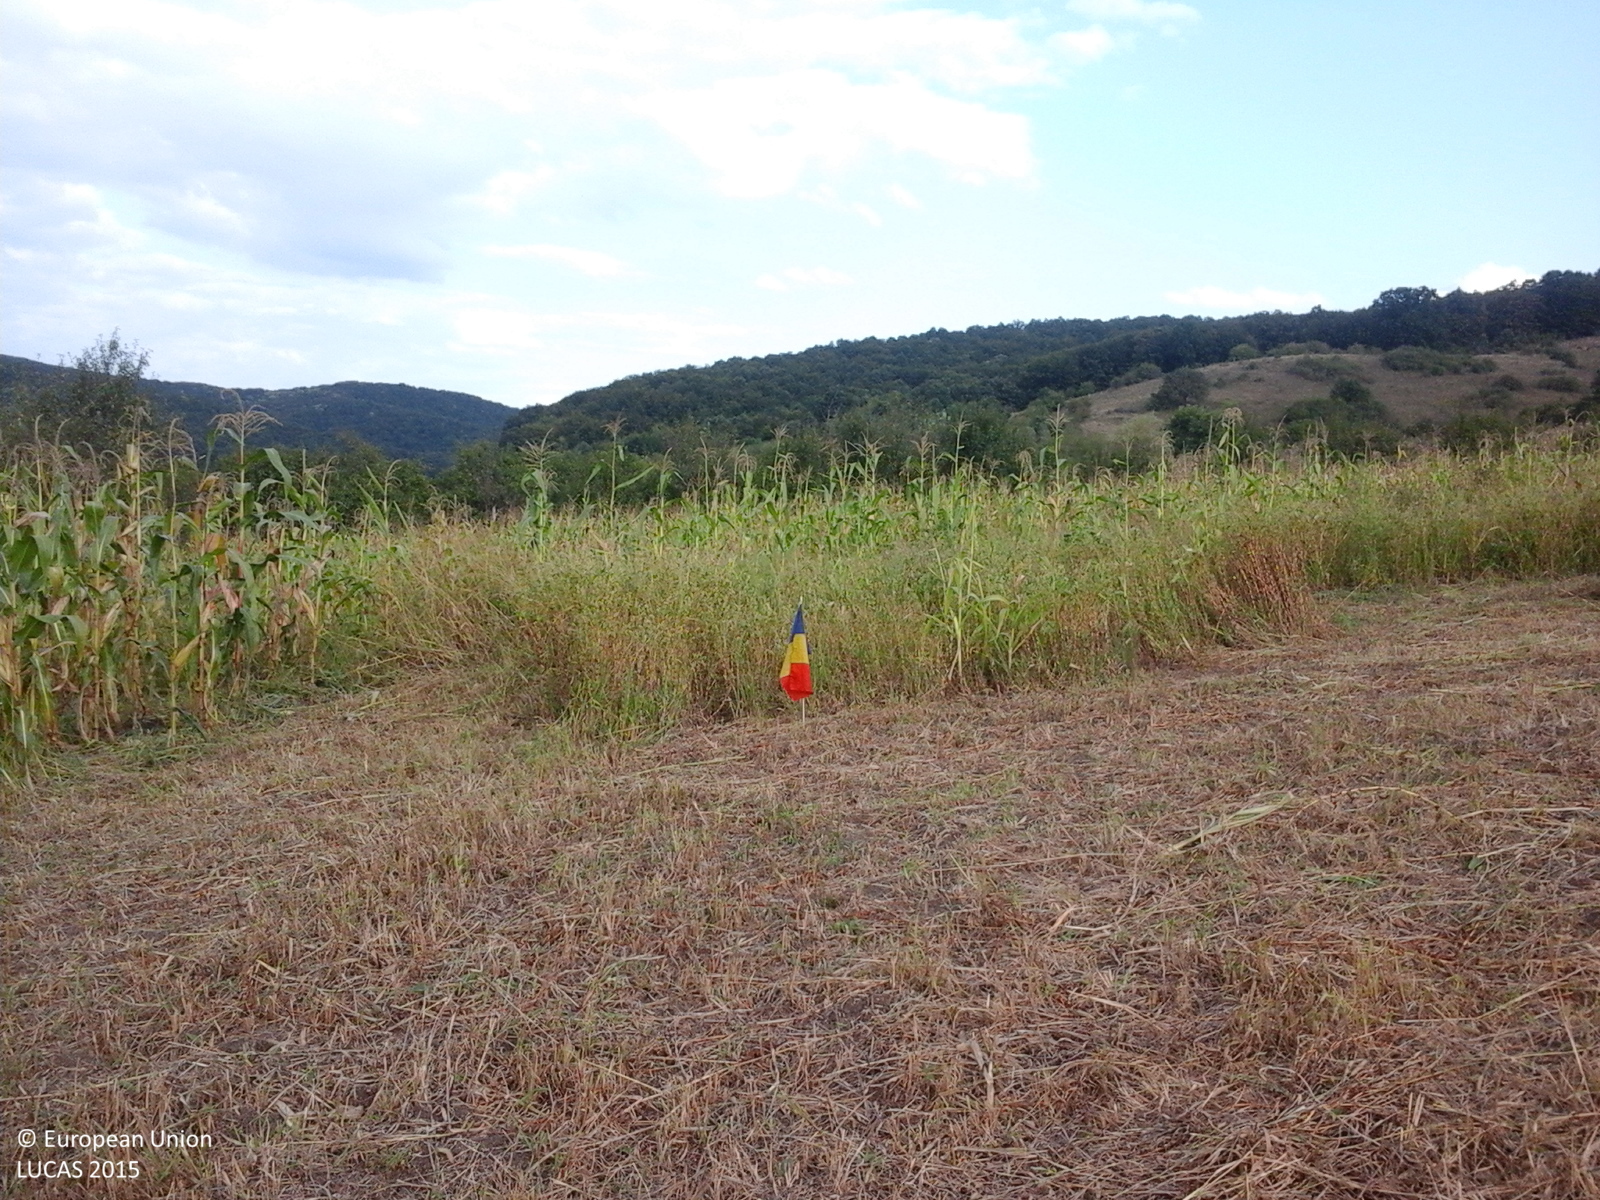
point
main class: Grassland
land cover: Grassland without tree/shrub cover
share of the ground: > 75 %
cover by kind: herbaceous plants 100 %
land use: Agriculture (excluding fallow land and kitchen gardens)
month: September
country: RO
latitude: 47.2980
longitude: 23.1994
